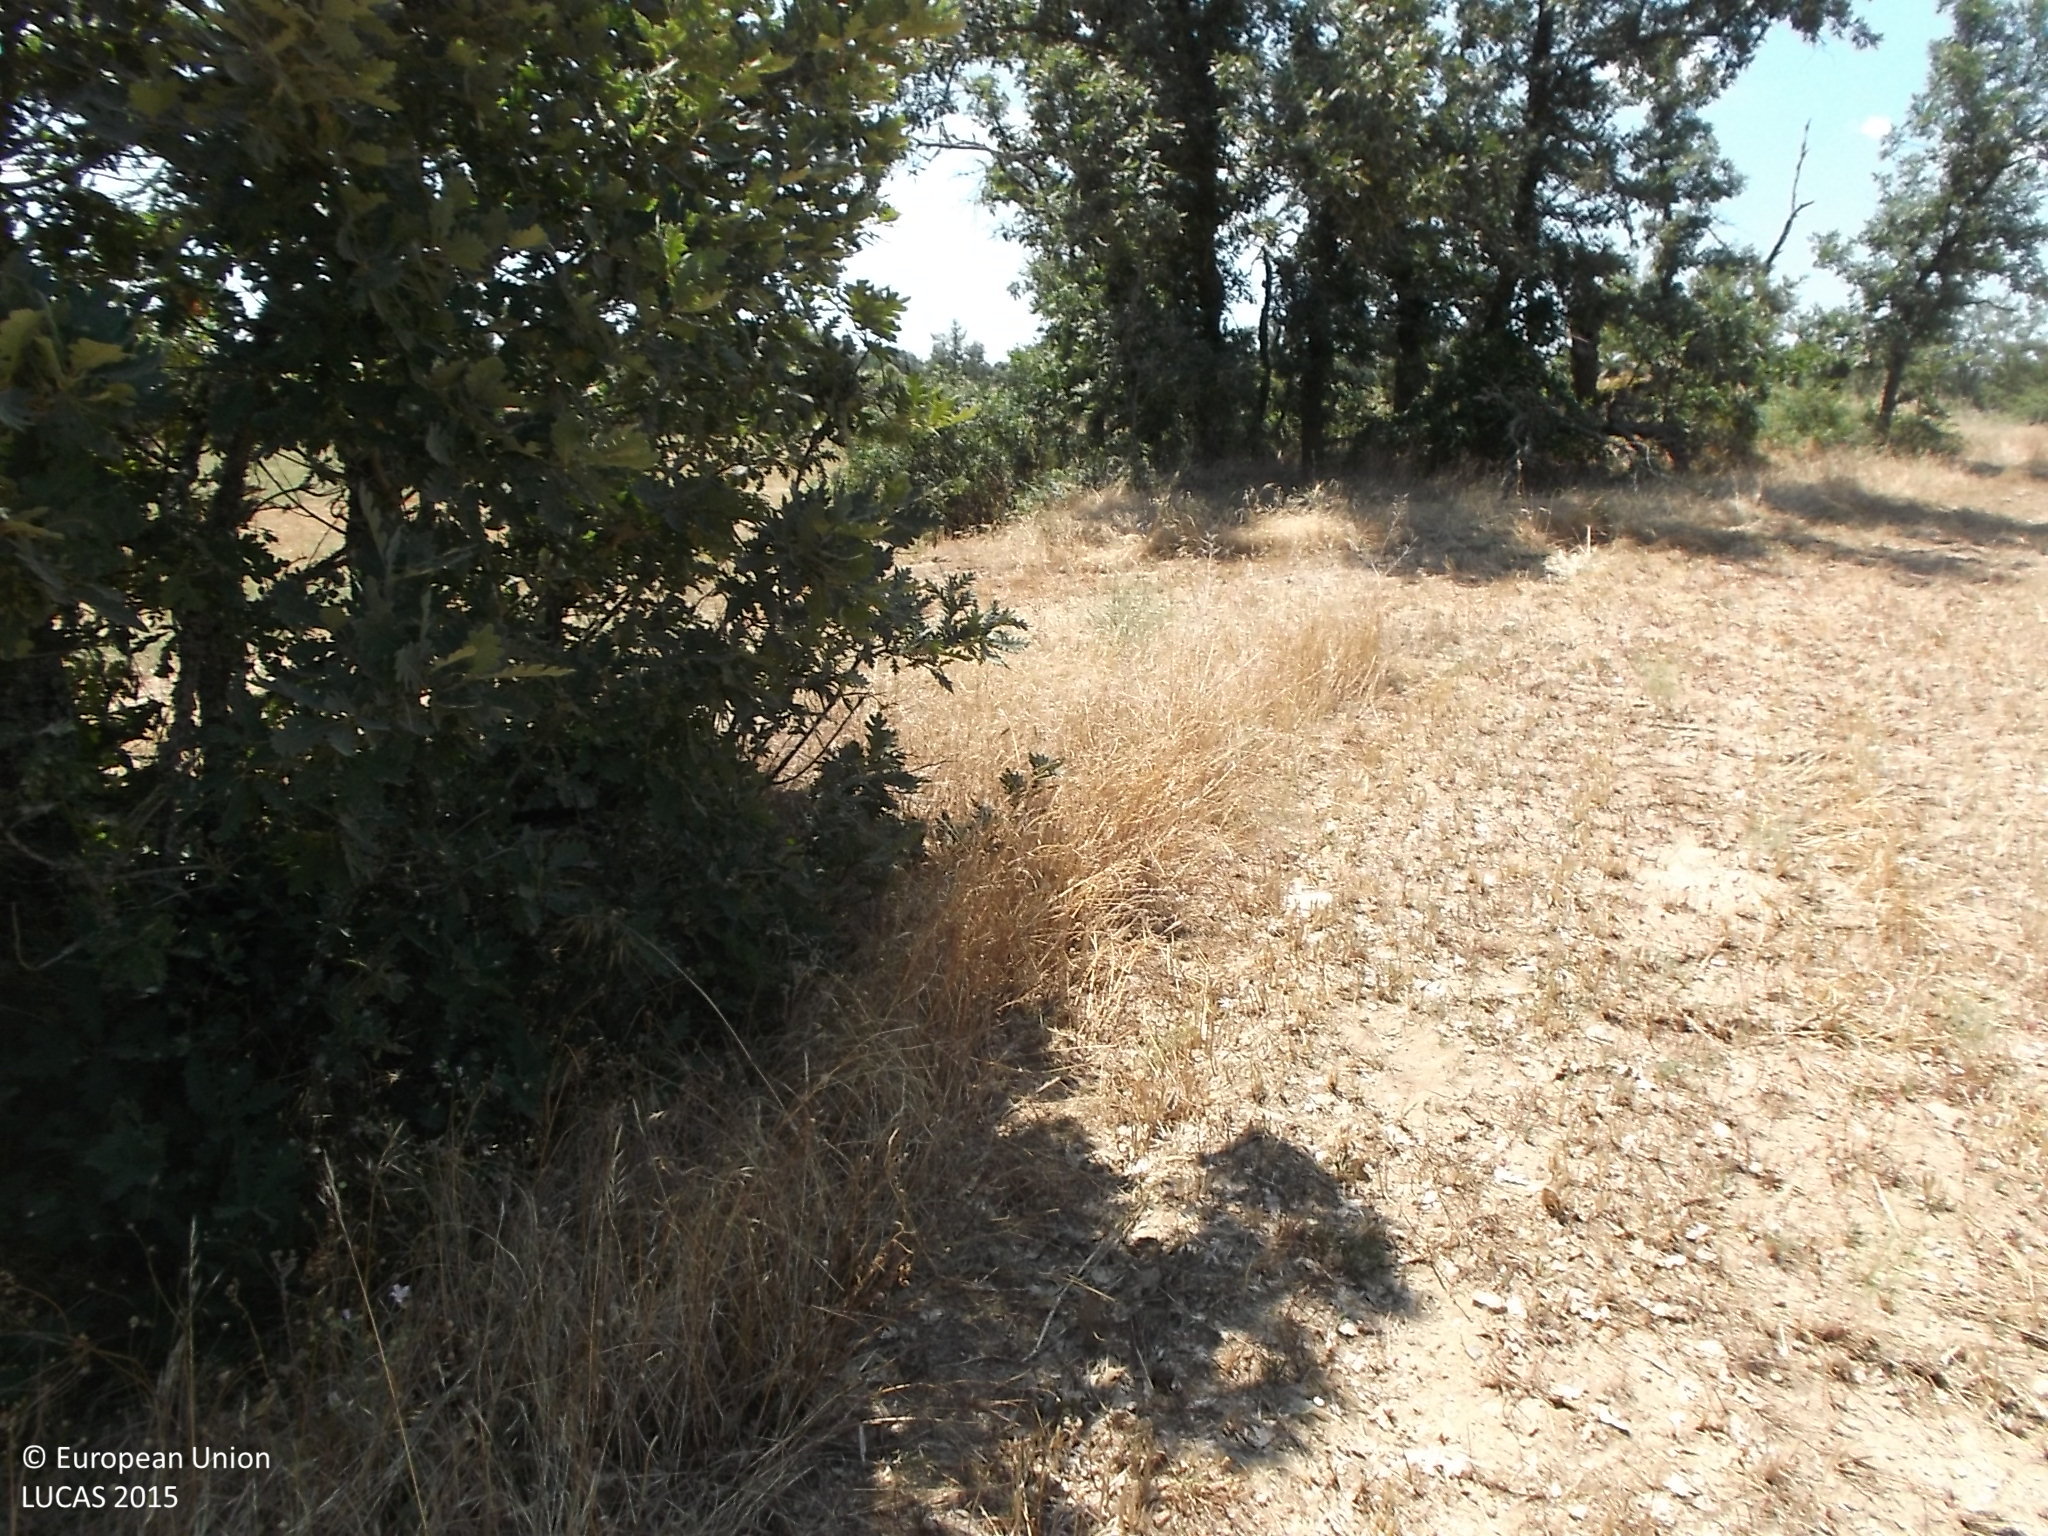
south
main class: Cropland
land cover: Oats
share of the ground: < 10 %
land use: Agriculture (excluding fallow land and kitchen gardens)
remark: Harvested field
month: July
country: ES
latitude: 41.4133
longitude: -6.0876
